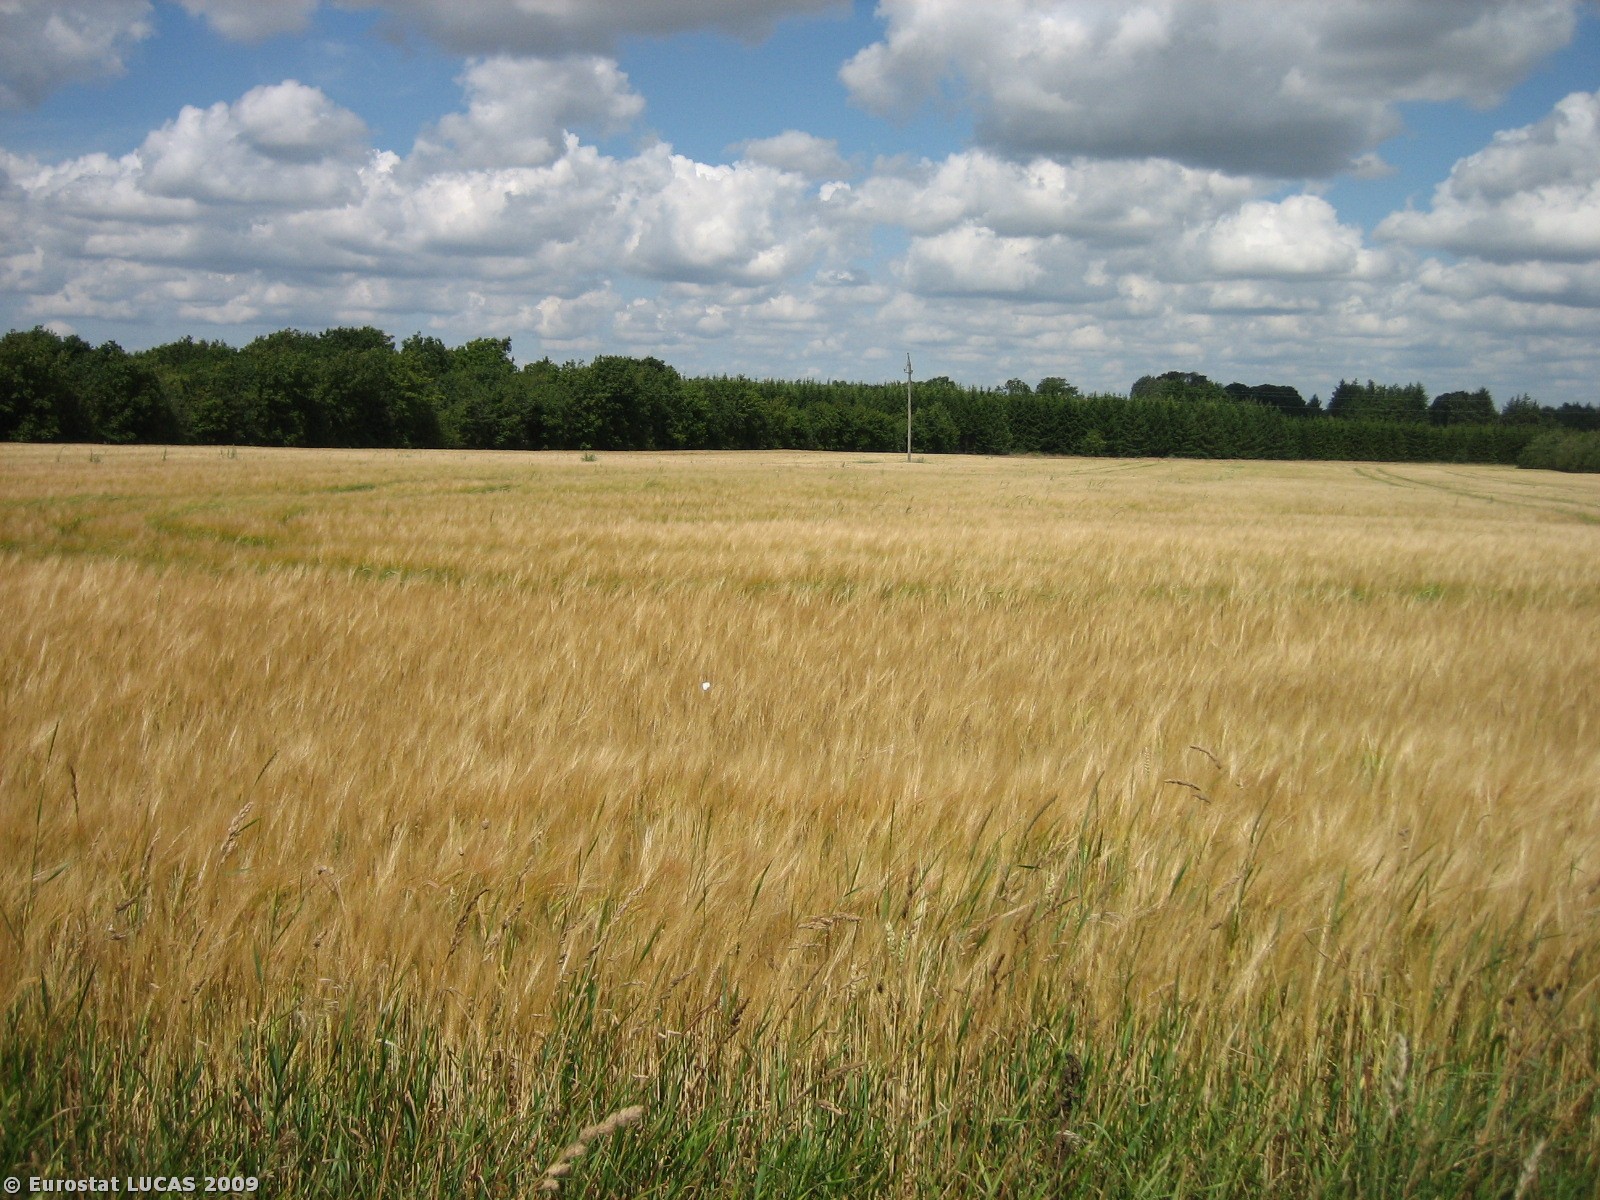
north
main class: Cropland
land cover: Barley
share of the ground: > 75 %
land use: Agriculture (excluding fallow land and kitchen gardens)
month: July
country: DK
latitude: 55.7164
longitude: 8.9982
